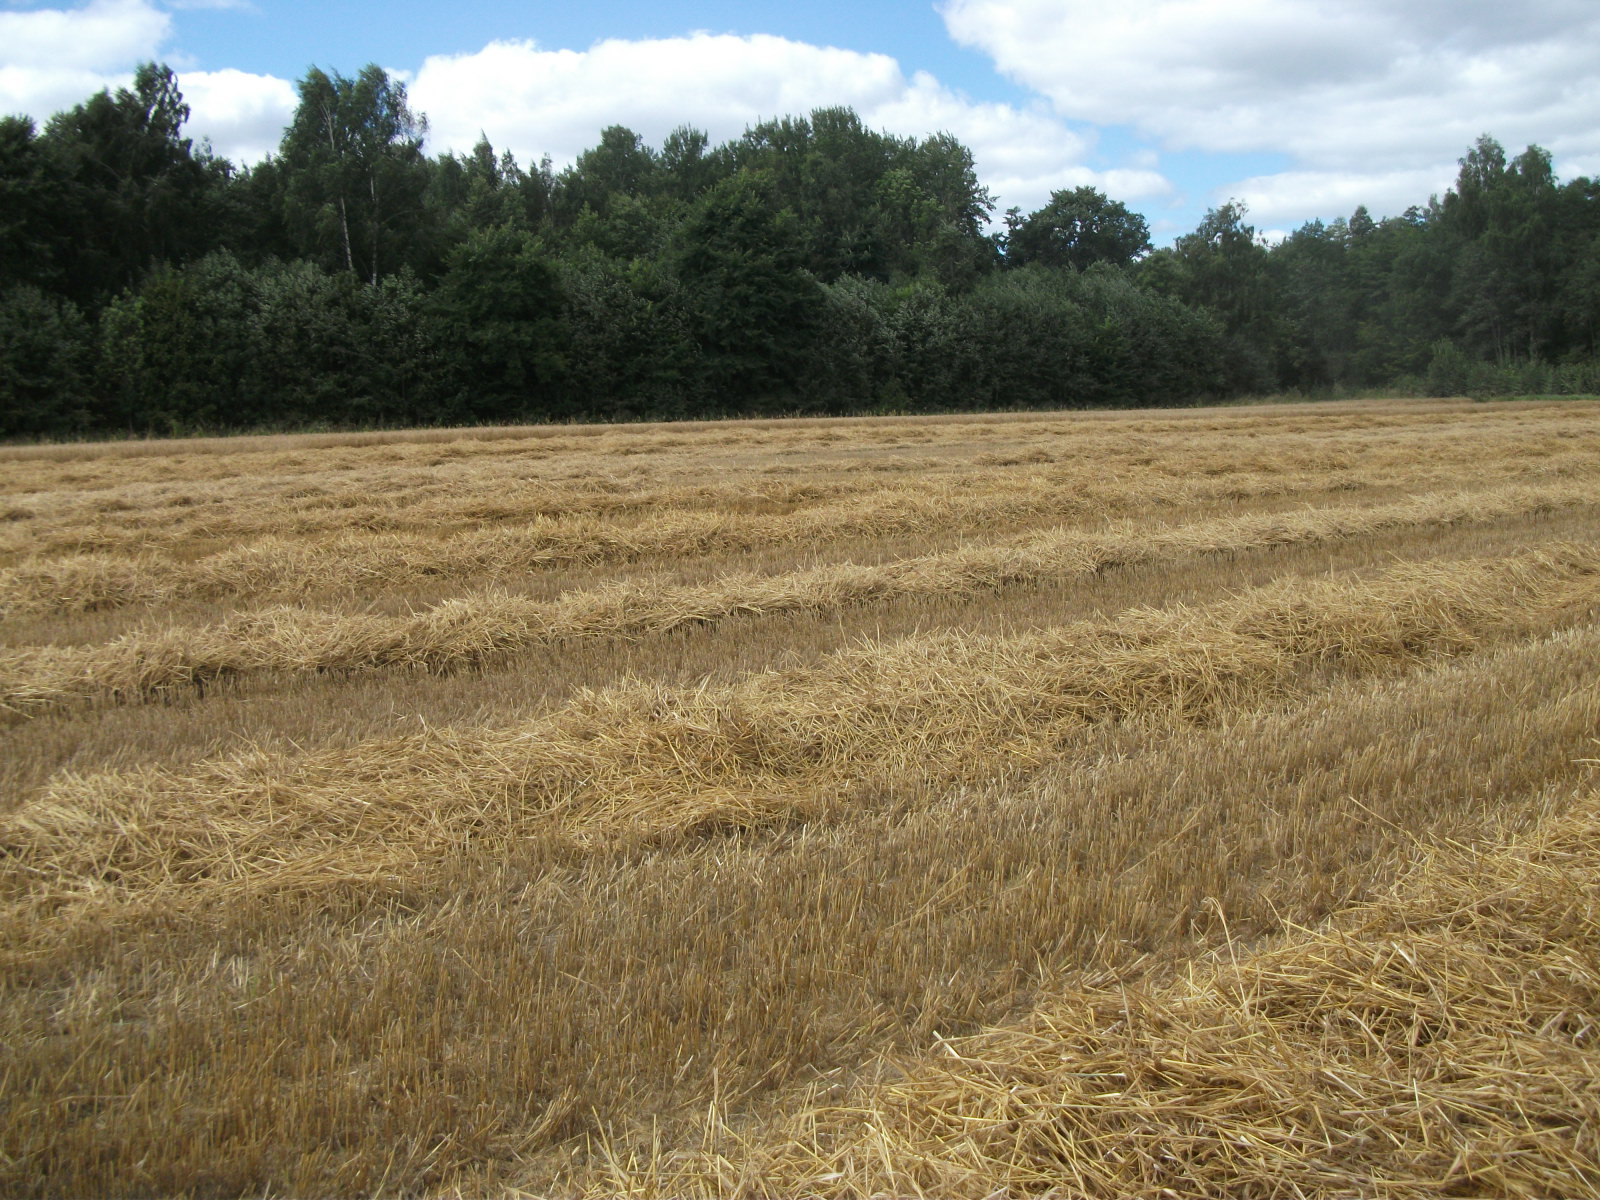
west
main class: Cropland
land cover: Barley
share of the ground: < 10 %
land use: Agriculture (excluding fallow land and kitchen gardens)
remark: Harvested field
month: August
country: LV
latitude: 56.5745
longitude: 26.4057
